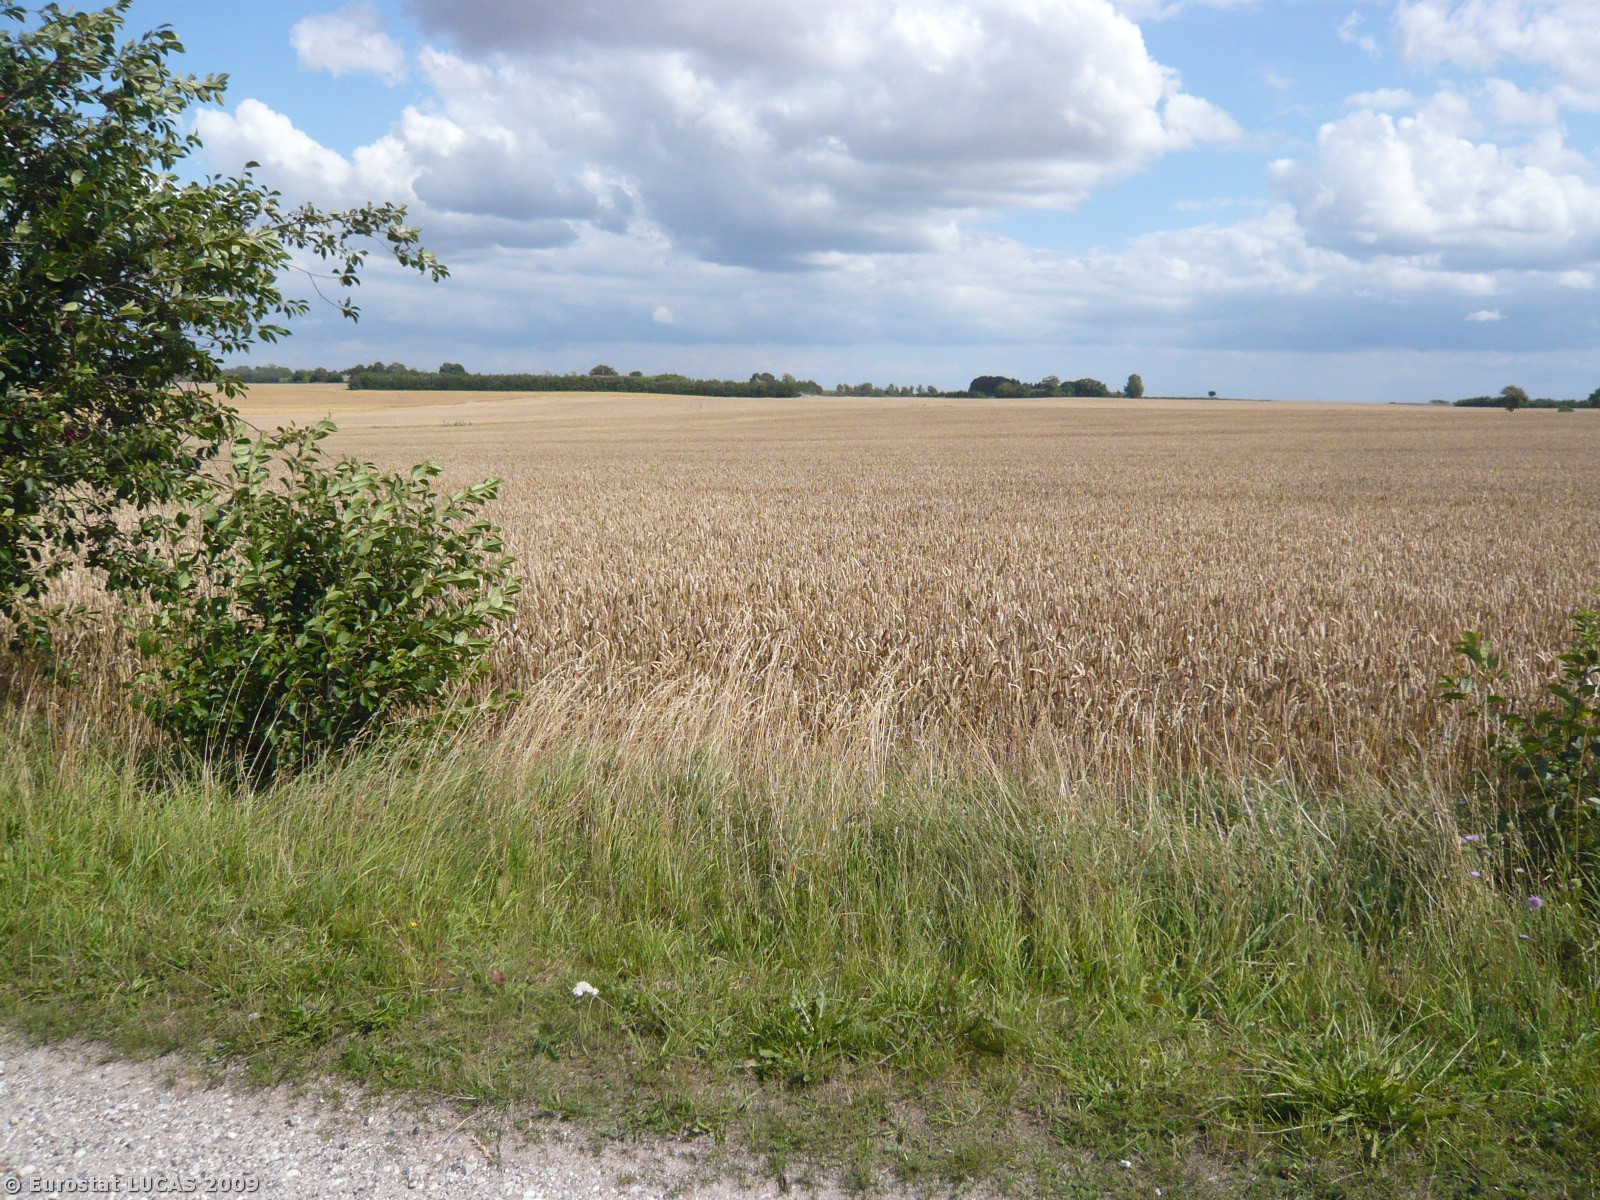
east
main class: Cropland
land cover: Common wheat
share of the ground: > 75 %
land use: Agriculture (excluding fallow land and kitchen gardens)
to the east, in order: Common wheat; Tracks; Grass margins; Common wheat
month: July
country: DK
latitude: 55.5596
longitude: 12.0753
